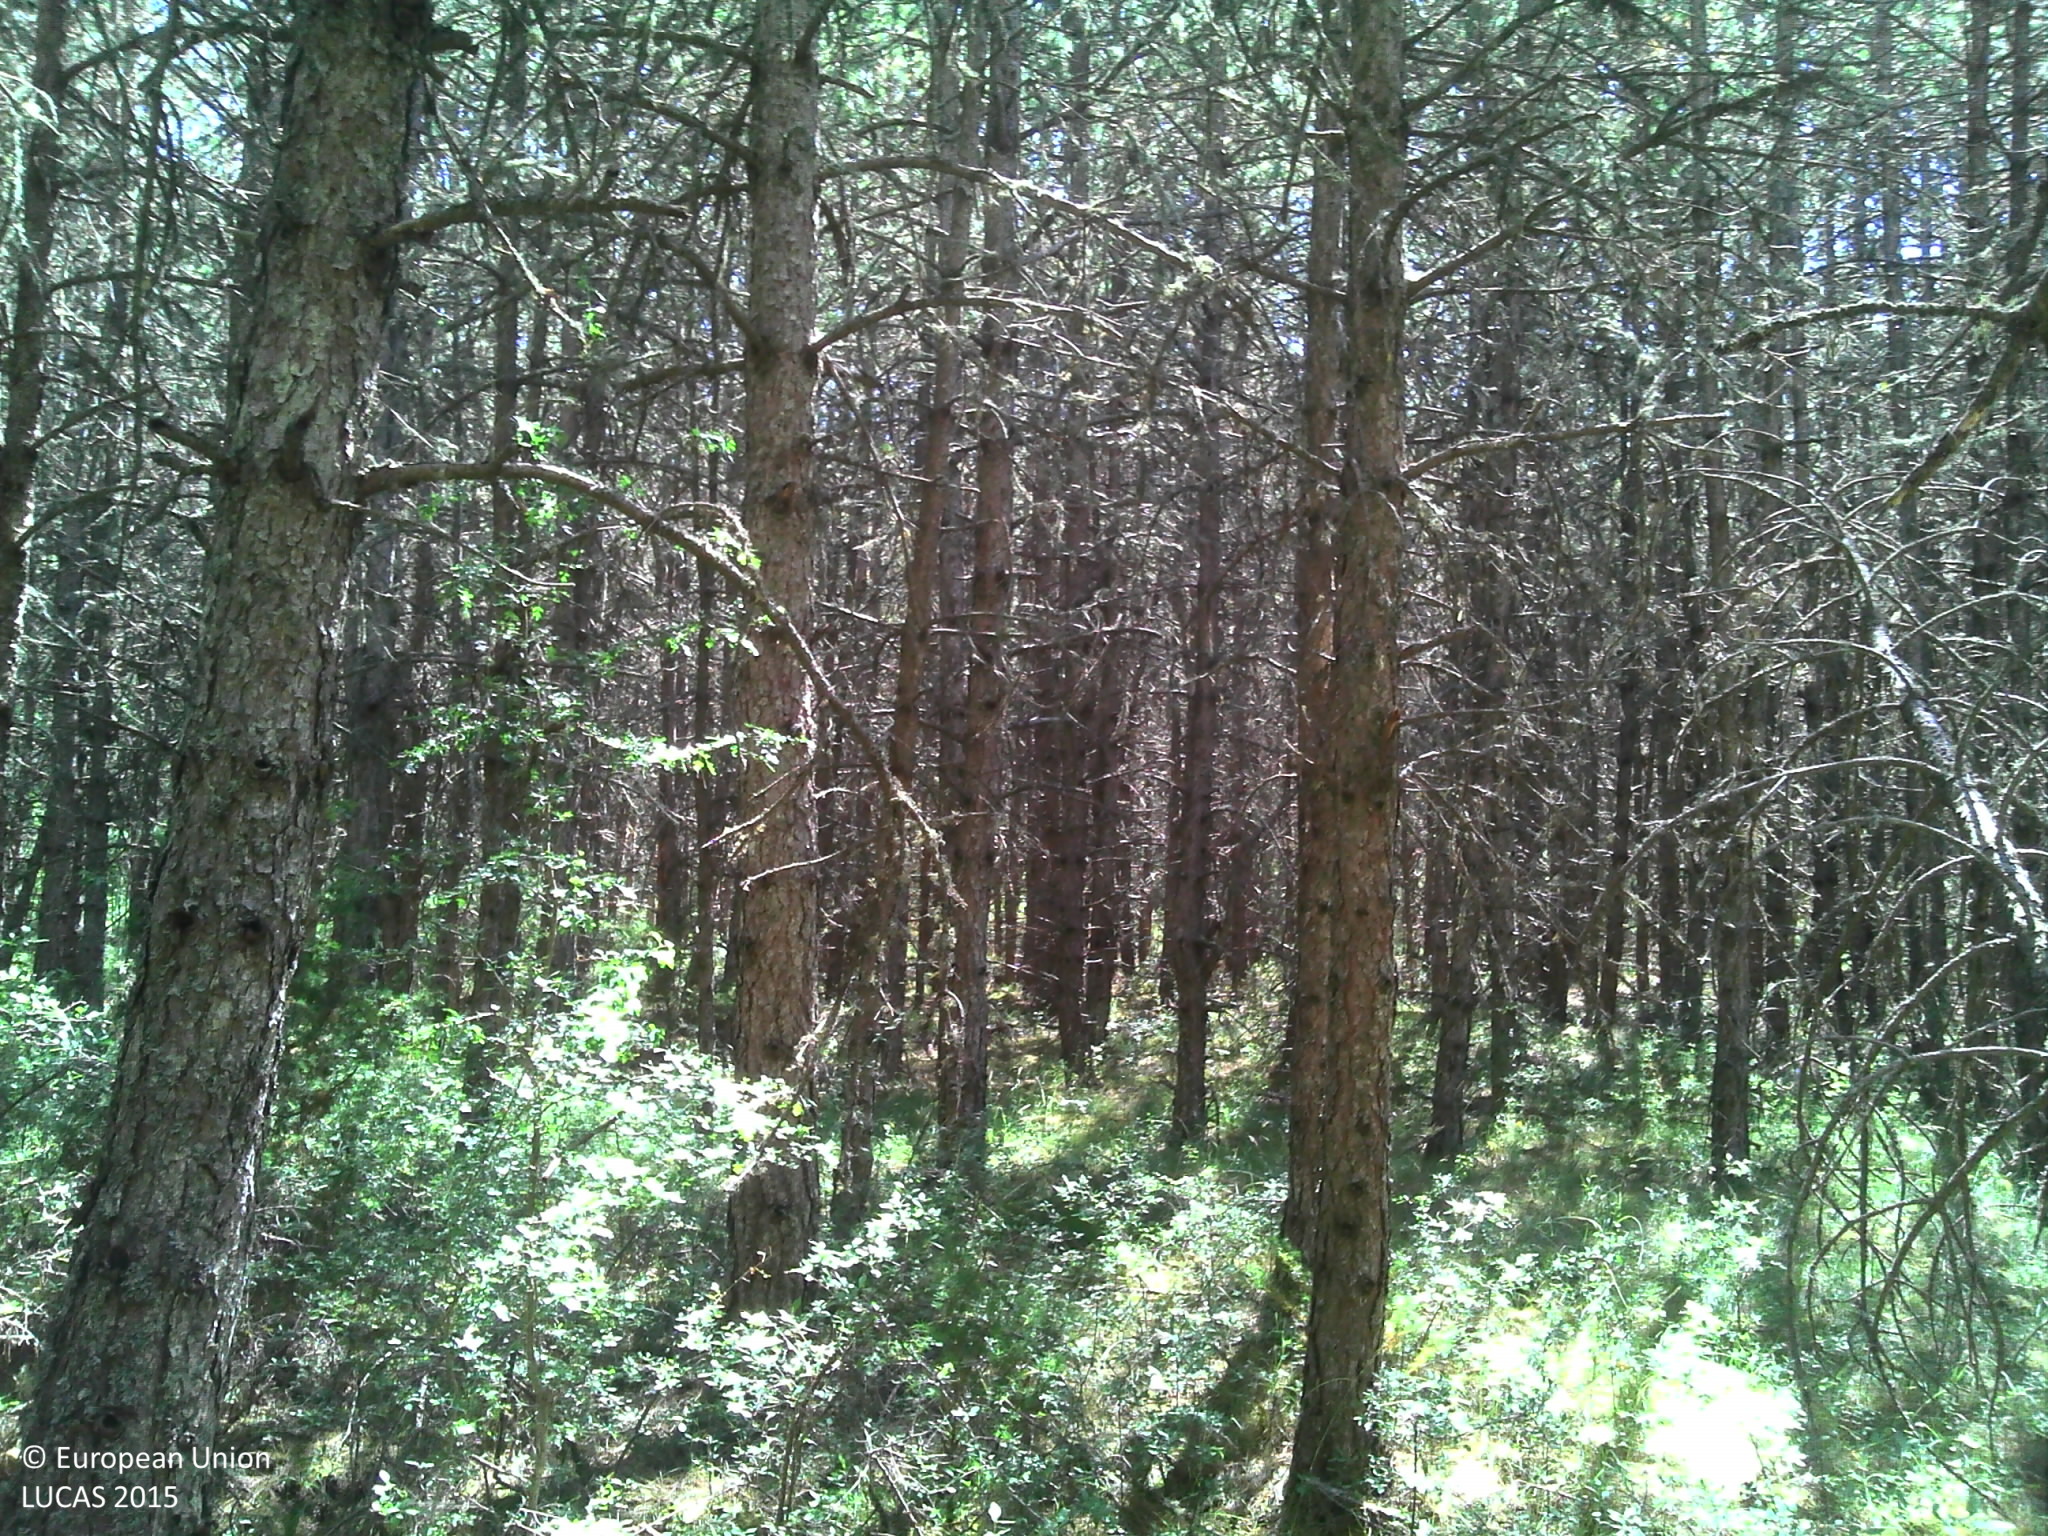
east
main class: Woodland
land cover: Pine dominated coniferous woodland
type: exotic forest
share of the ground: > 75 %
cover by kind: coniferous forest trees 85 %, broadleaved forest trees 5 %, shrubs 5 %, herbaceous plants 5 %
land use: Forestry
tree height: > 5 m
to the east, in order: Pine dominated coniferous woodland; Tracks; Pine dominated coniferous woodland
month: July
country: FR
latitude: 44.3637
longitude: 3.2168
